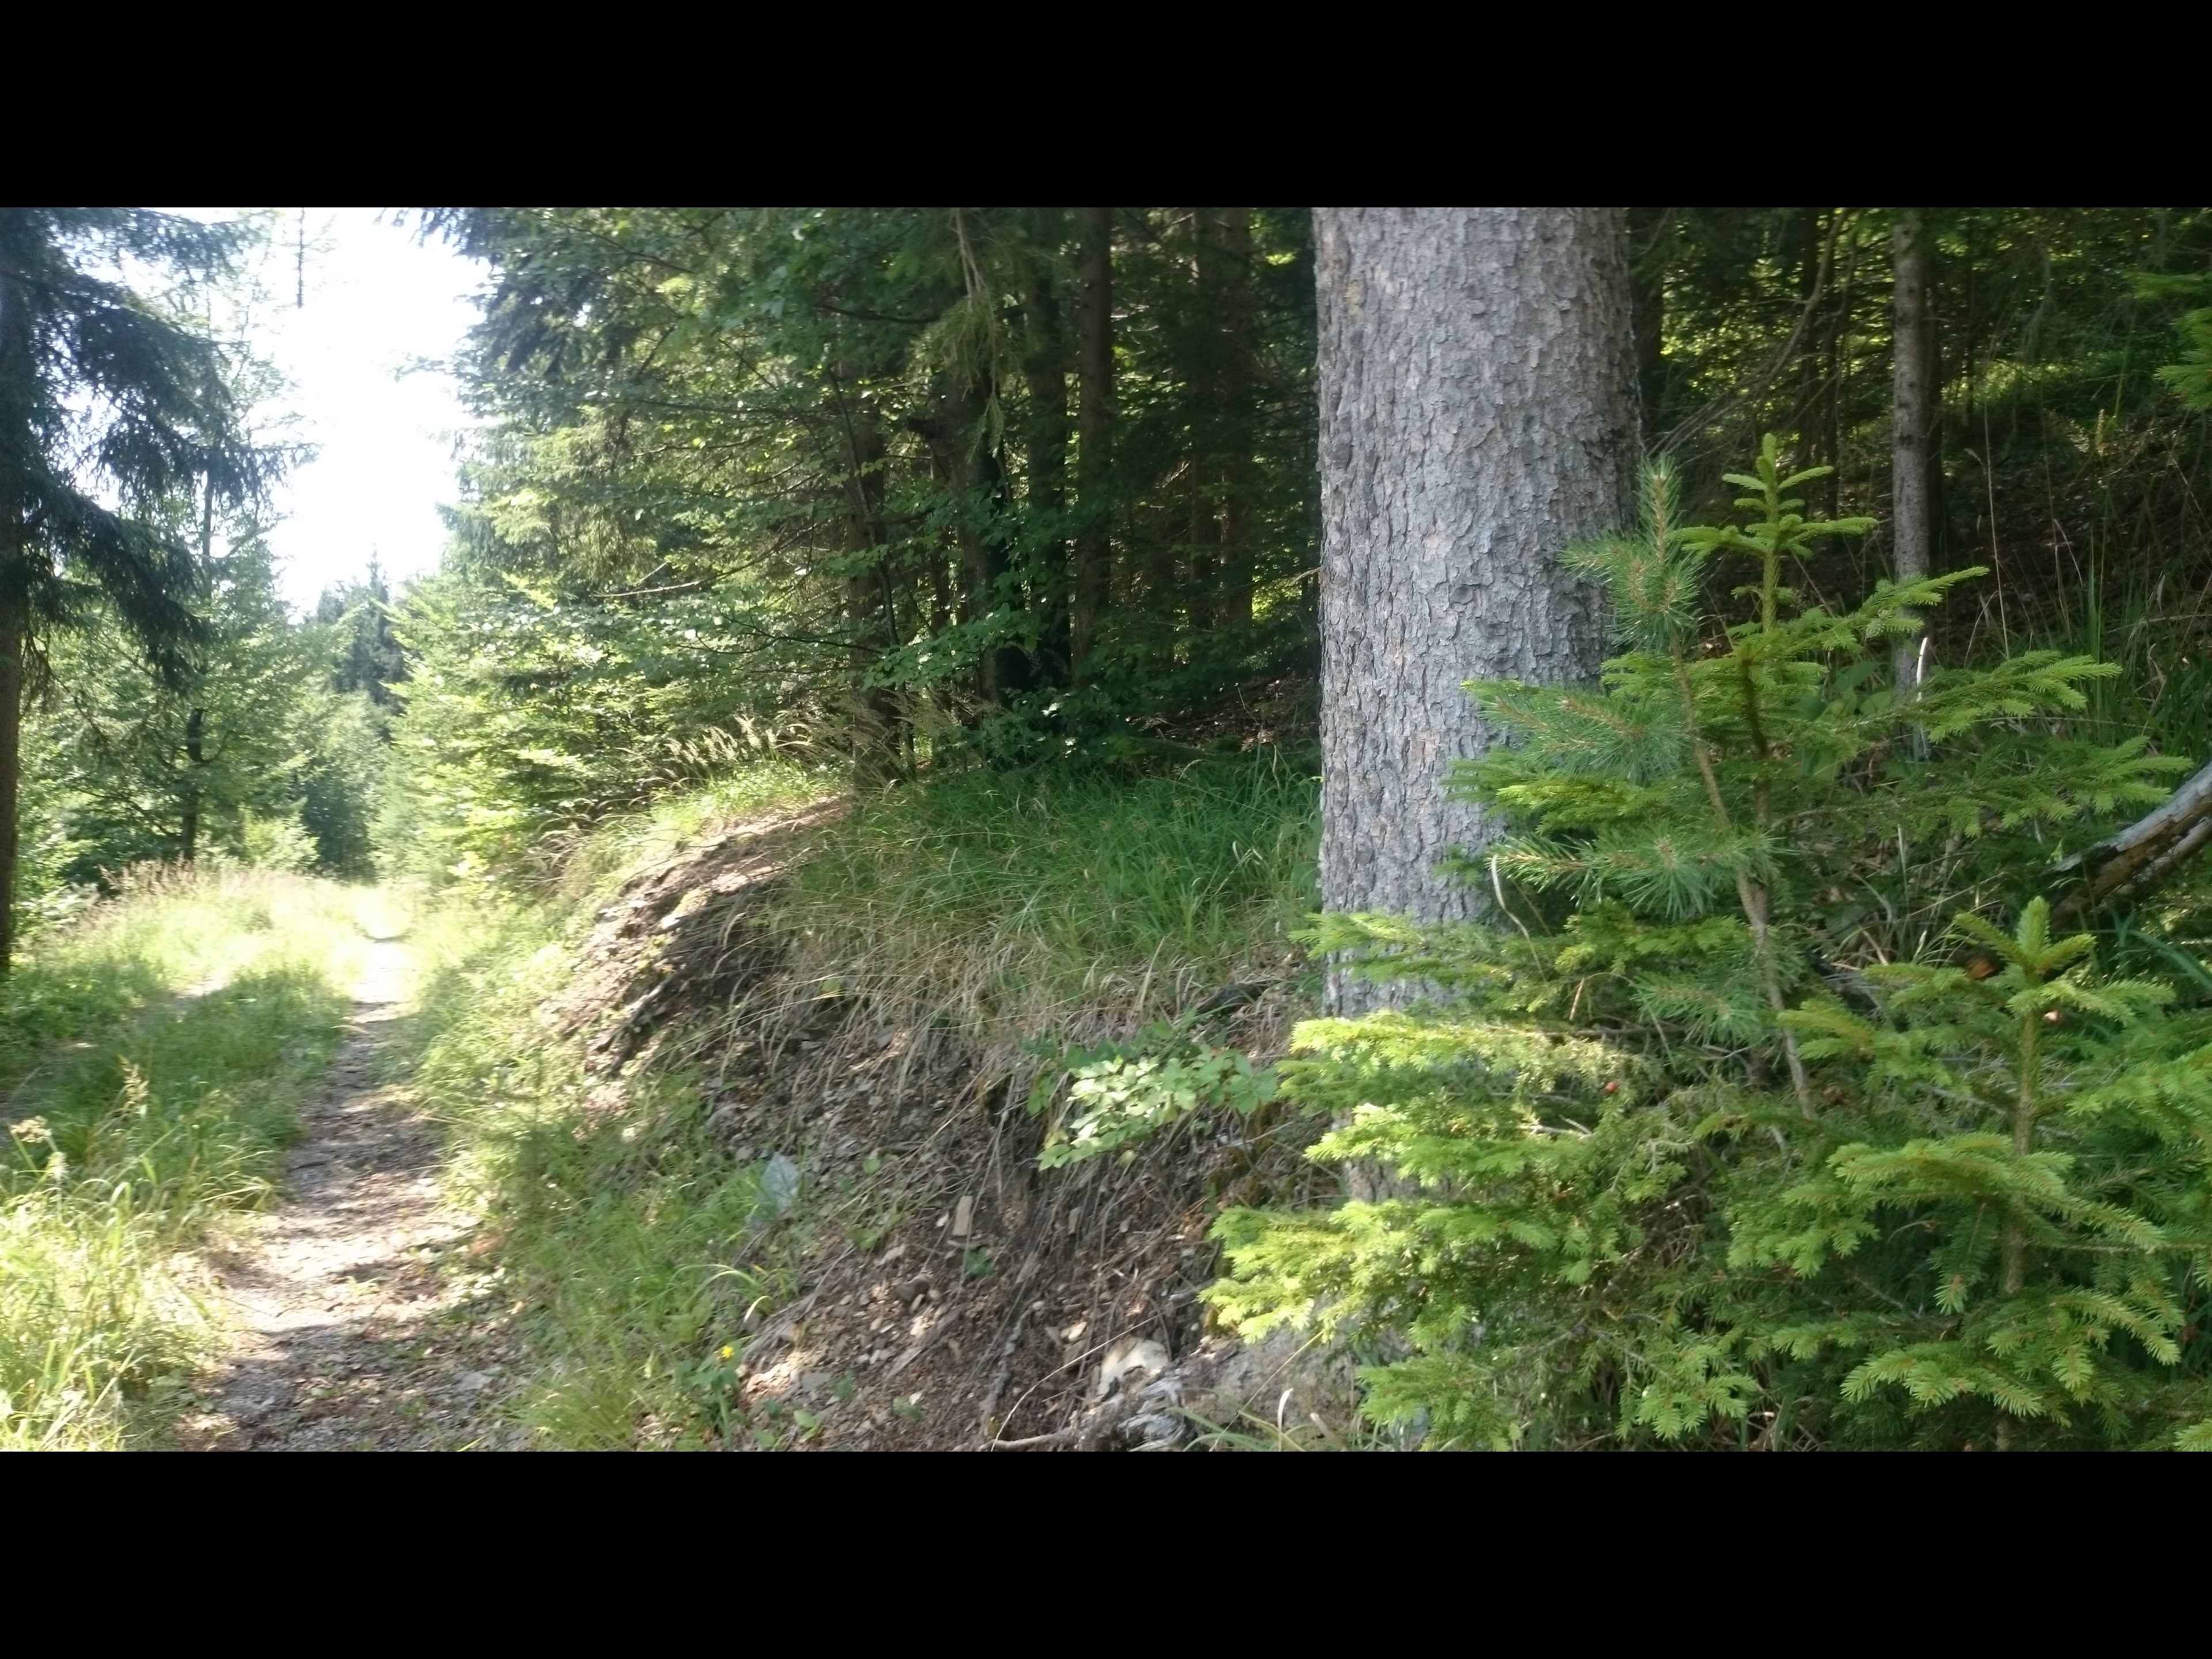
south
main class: Woodland
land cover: Spruce dominated mixed woodland
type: hemiboreal forest and nemoral coniferous forest and mixed broadleaved-coniferous forest
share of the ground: > 75 %
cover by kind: coniferous forest trees 65 %, broadleaved forest trees 25 %, herbaceous plants 10 %
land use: Forestry
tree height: > 5 m
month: July
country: AT
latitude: 47.1855
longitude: 15.4769
